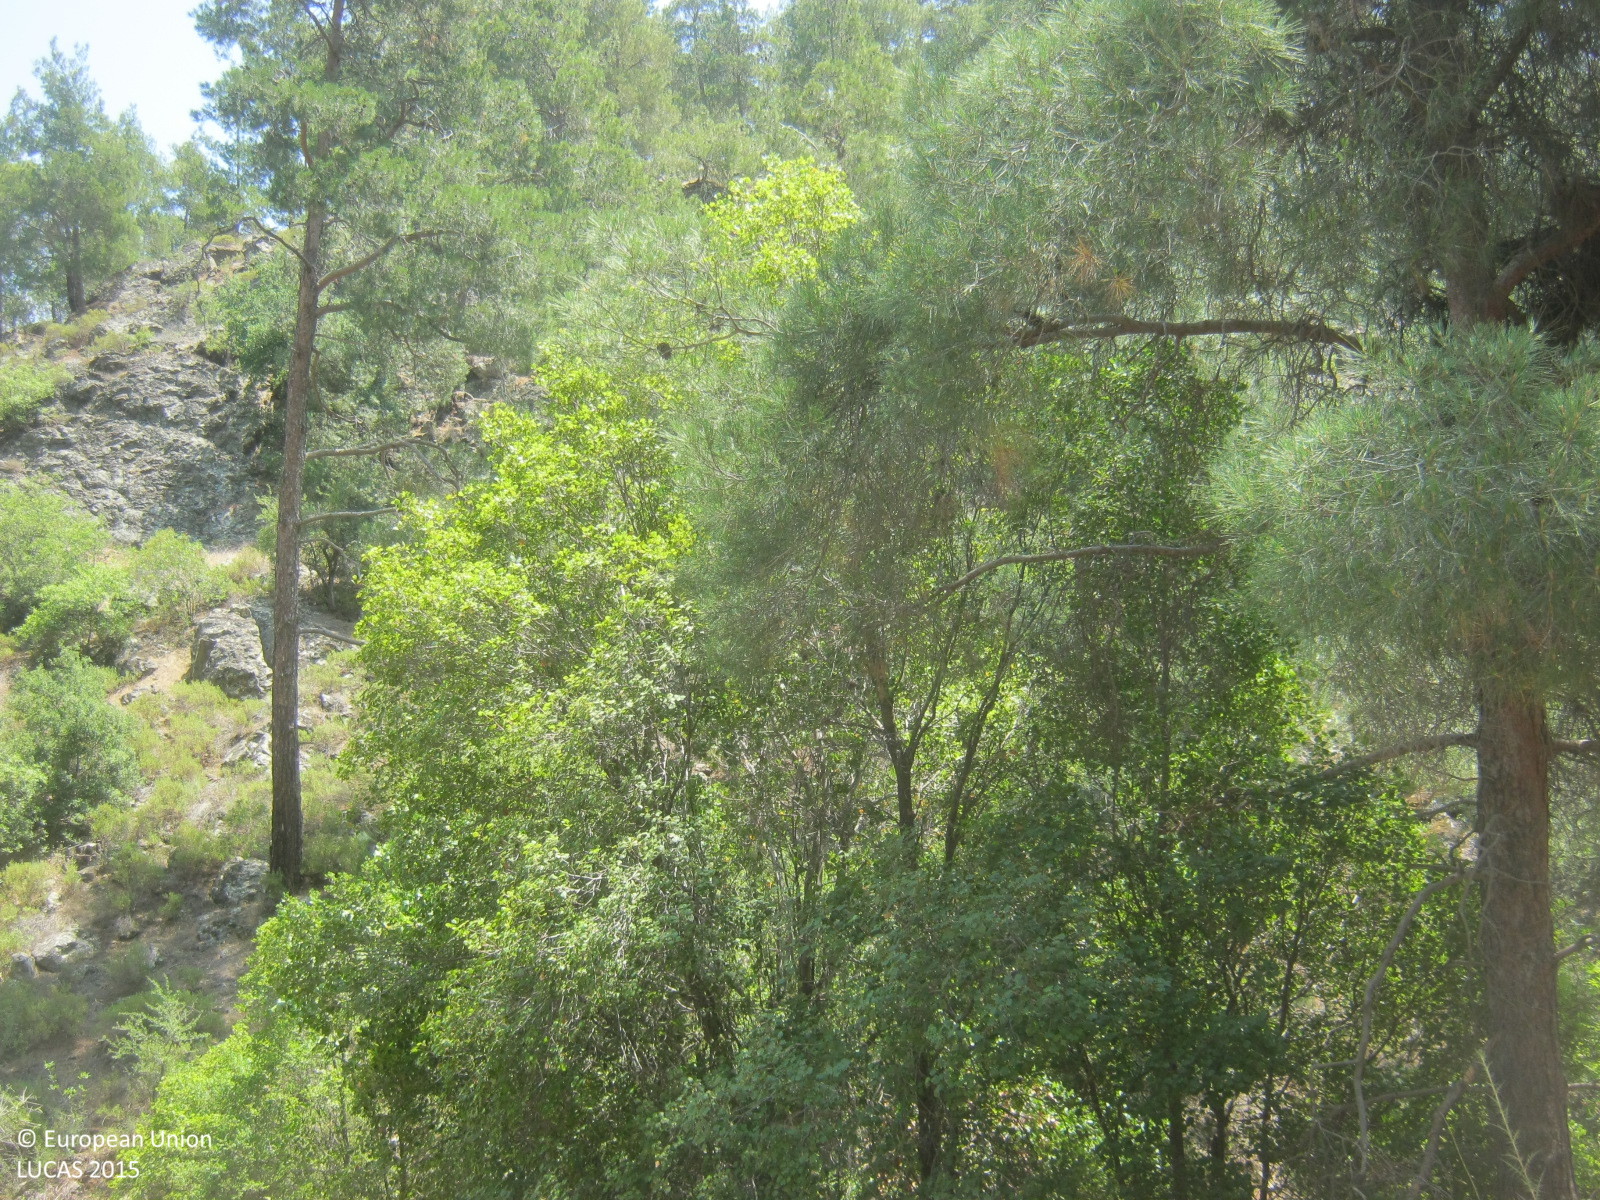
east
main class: Woodland
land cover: Pine dominated coniferous woodland
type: coniferous forest of the mediterranean region
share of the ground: > 75 %
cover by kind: coniferous forest trees 75 %, unconsolidated bare surface 15 %, shrubs 10 %
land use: Forestry
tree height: > 5 m
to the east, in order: Pine dominated coniferous woodland; Ditches and canals; Pine dominated coniferous woodland; Tracks; Pine dominated coniferous woodland; Tracks; Artificial constructions; Pine dominated coniferous woodland
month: June
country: CY
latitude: 35.0130
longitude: 33.0237
